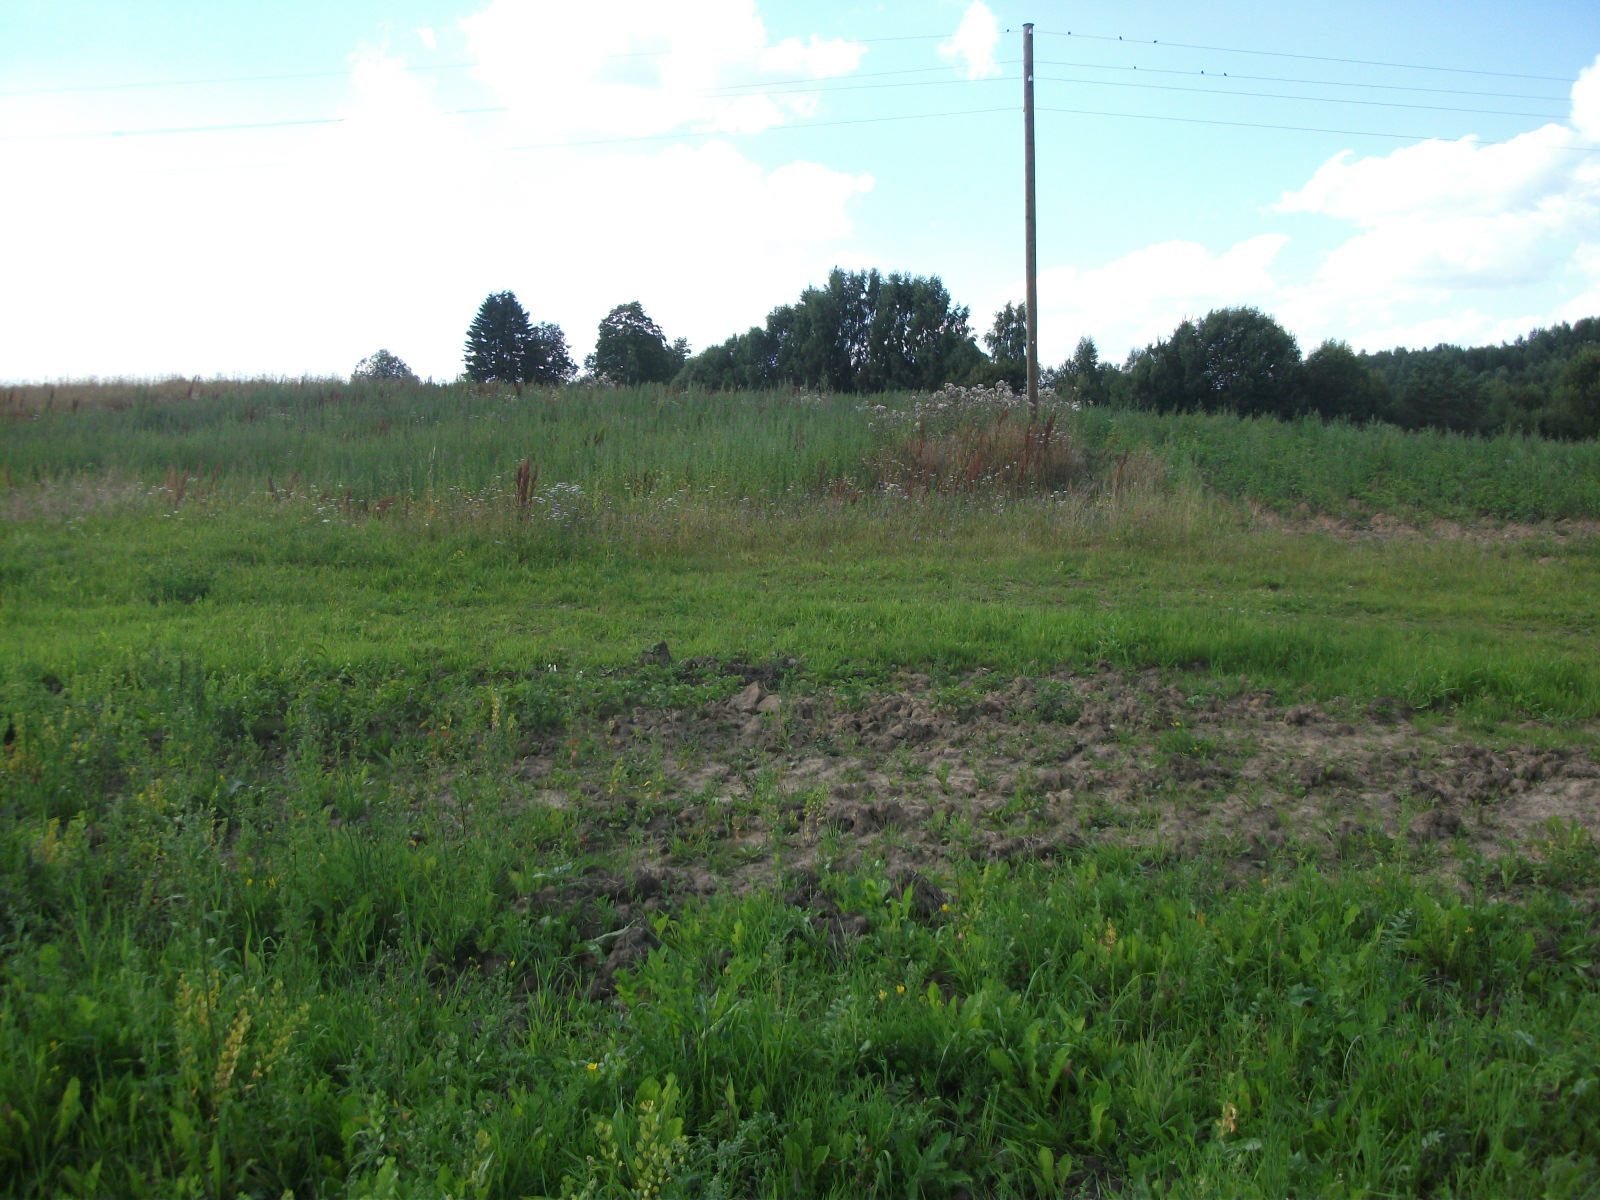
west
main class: Grassland
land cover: Grassland without tree/shrub cover
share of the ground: > 75 %
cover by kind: herbaceous plants 100 %
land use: Agriculture (excluding fallow land and kitchen gardens)
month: August
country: LV
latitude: 57.0797
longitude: 26.6303
